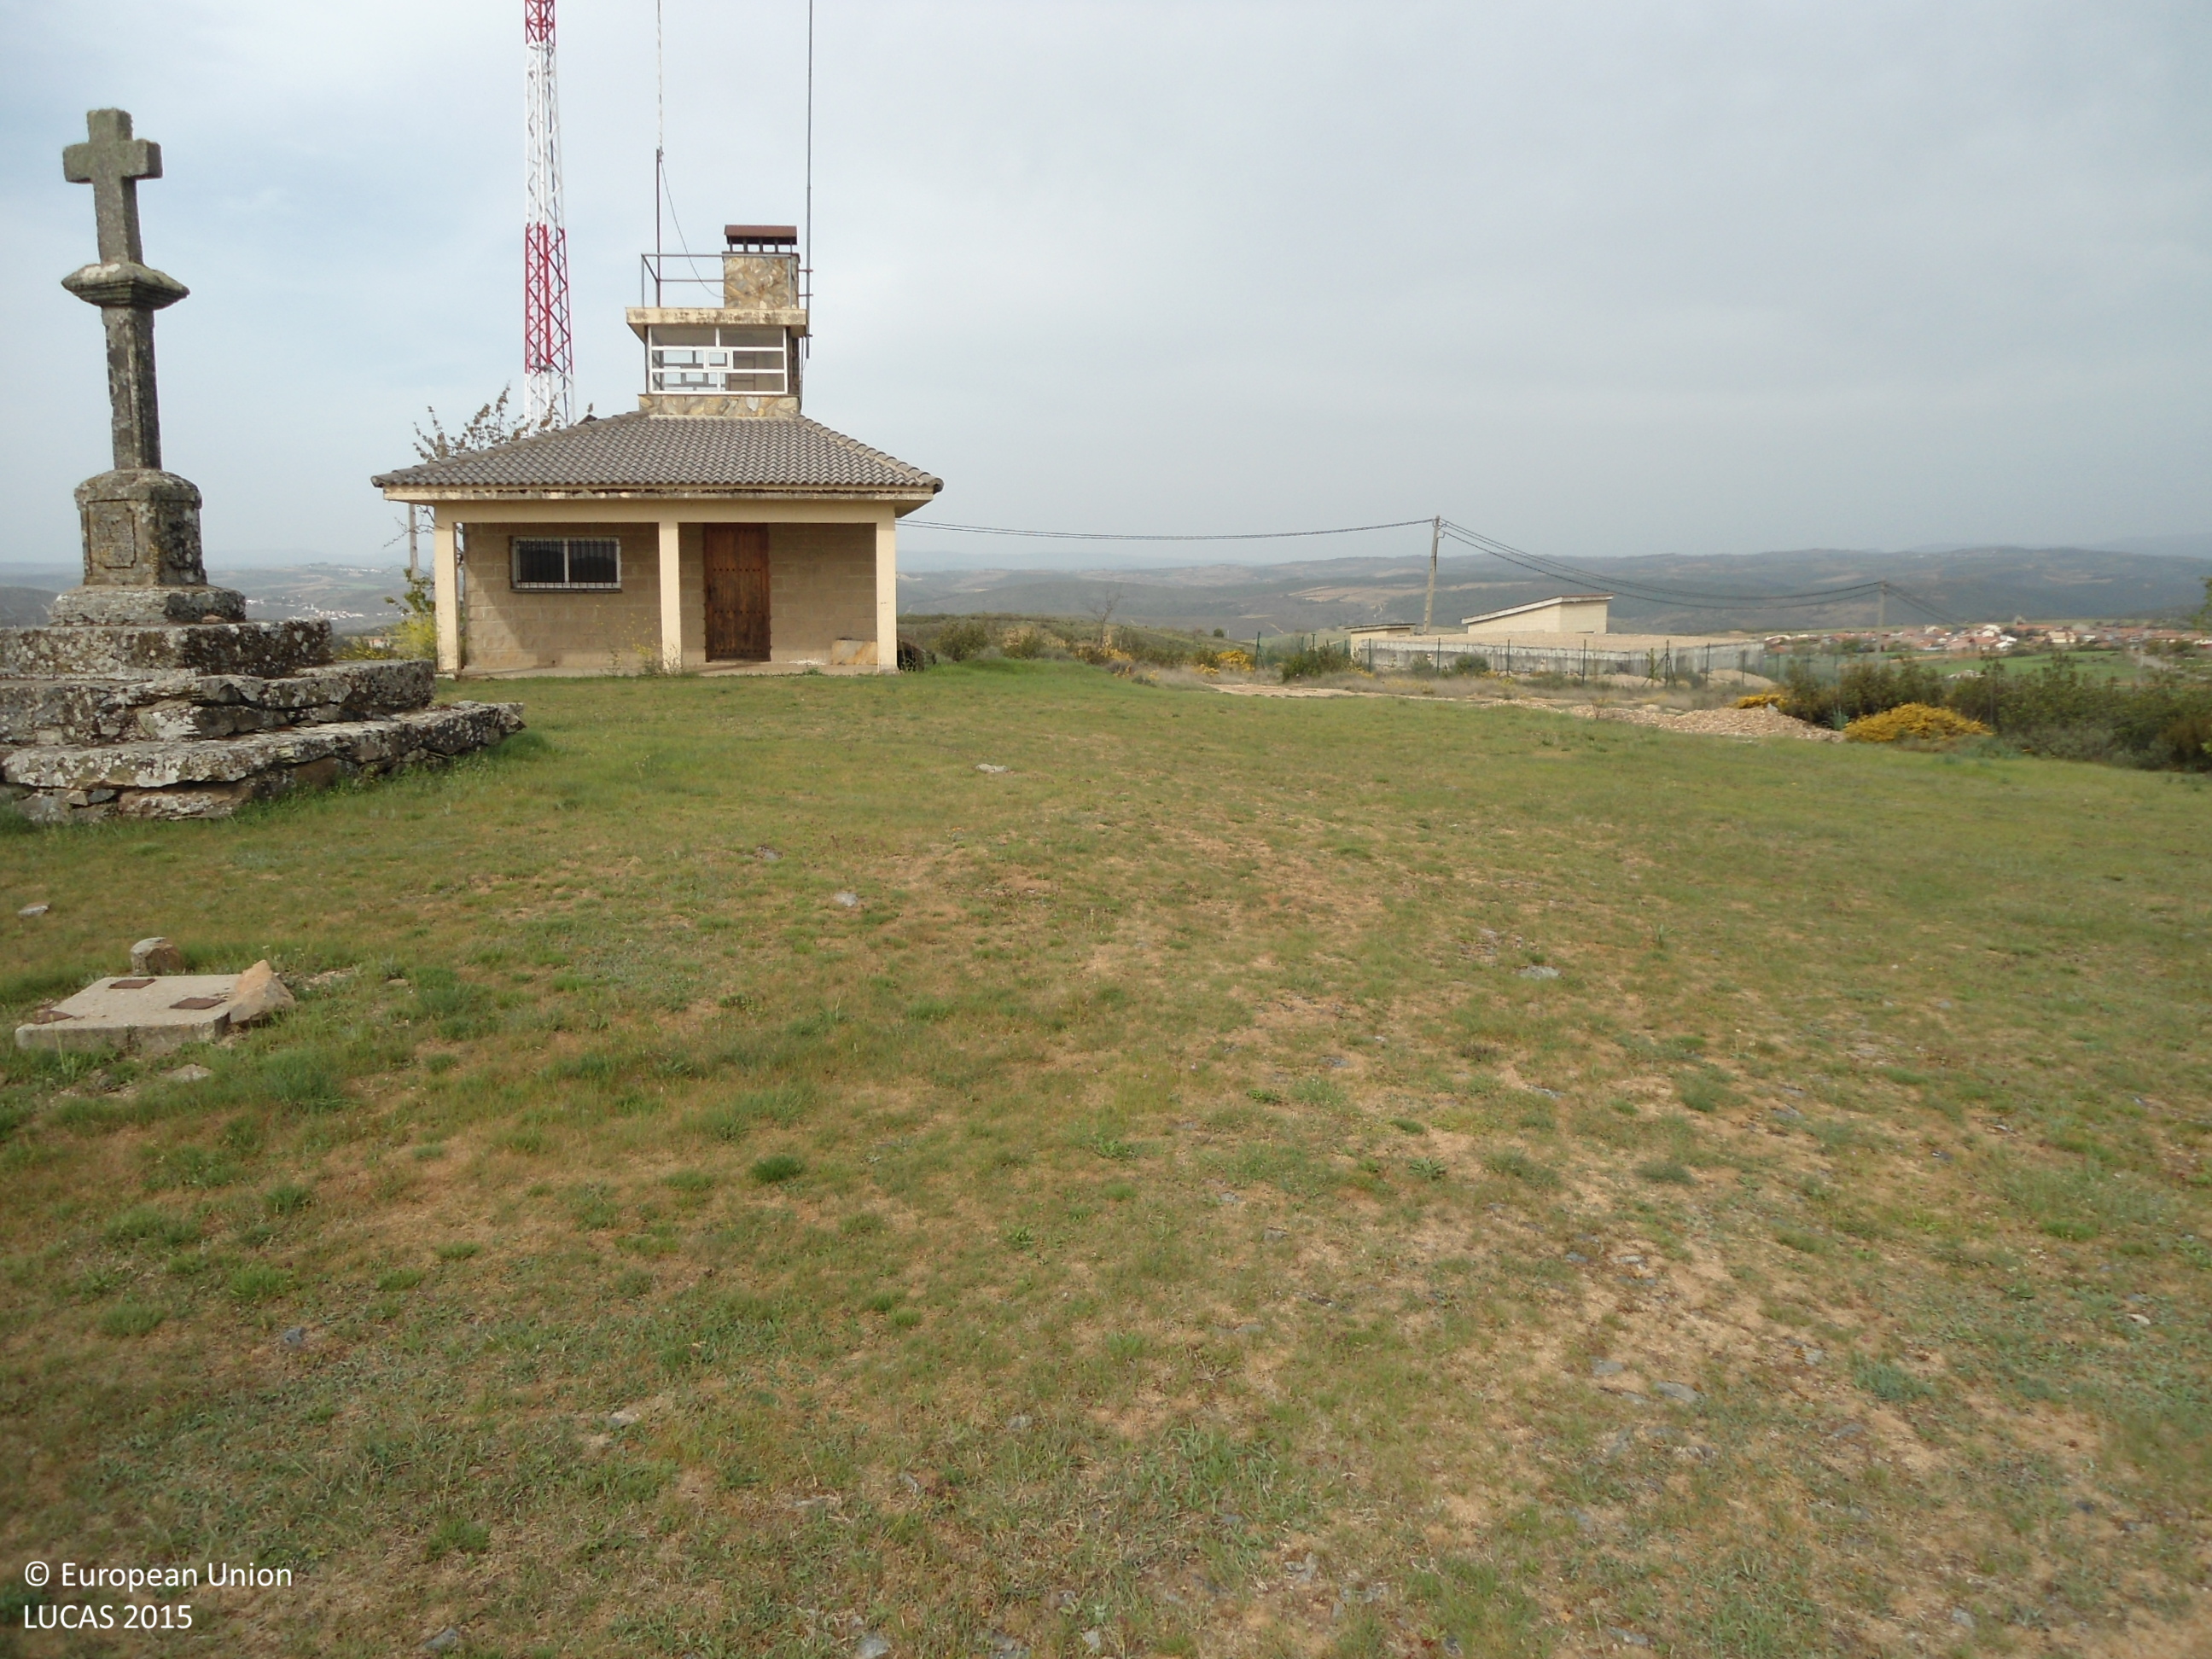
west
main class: Grassland
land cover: Grassland without tree/shrub cover
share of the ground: > 75 %
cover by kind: herbaceous plants 100 %
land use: Community services
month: April
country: ES
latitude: 41.7677
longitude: -6.5024
